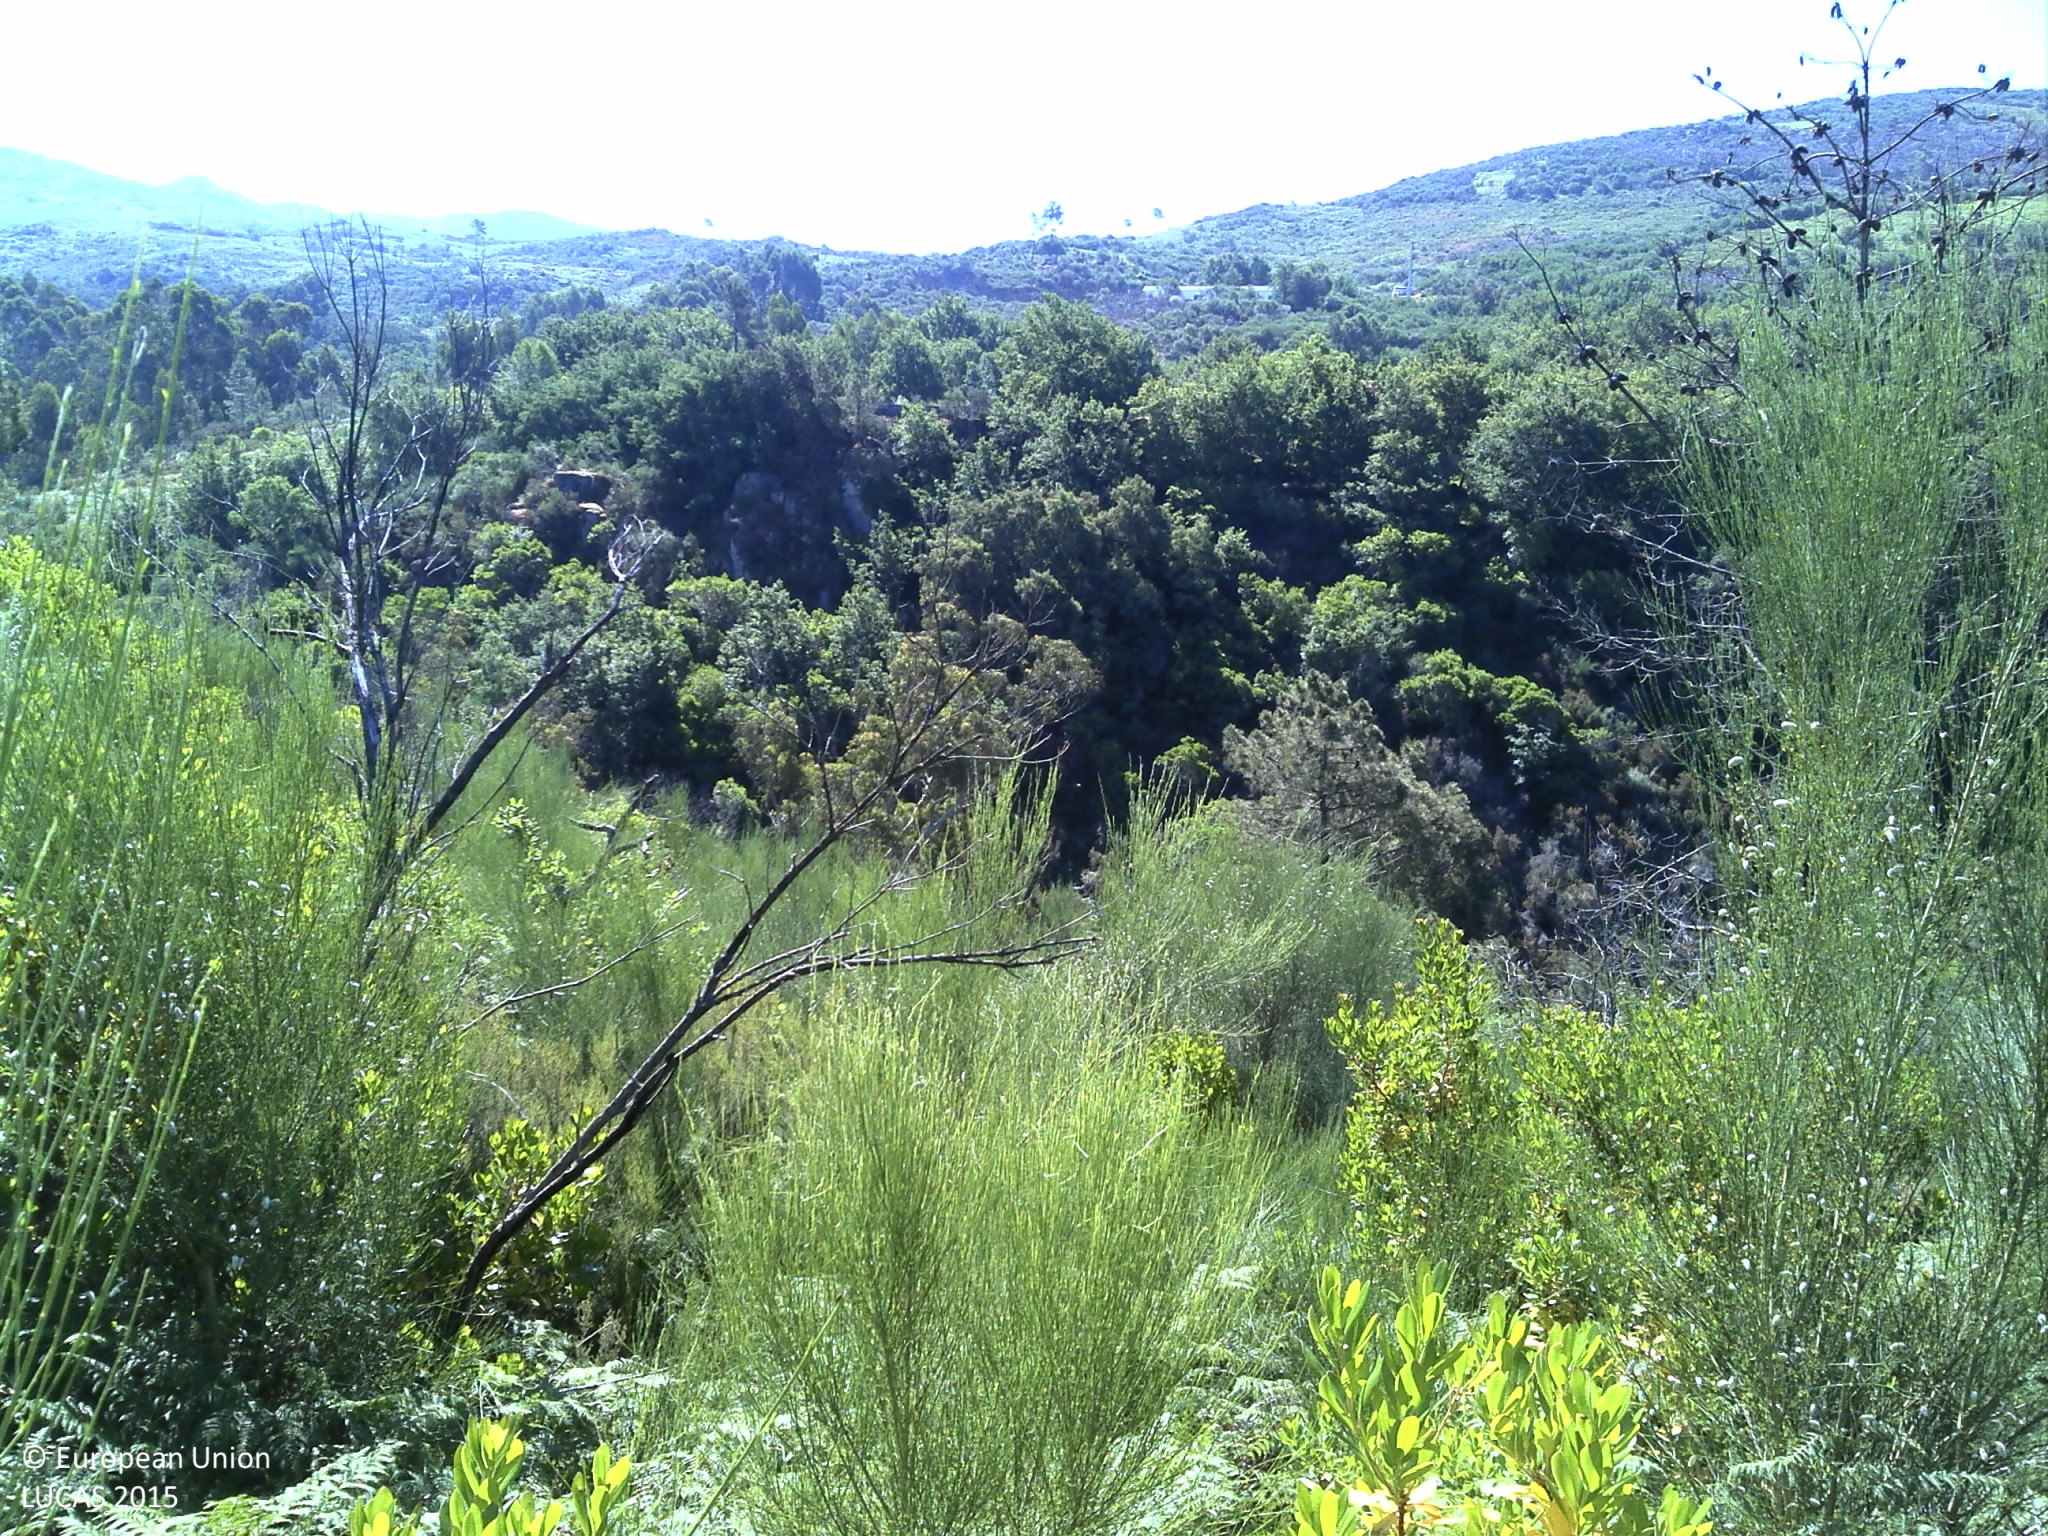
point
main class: Shrubland
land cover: Shrubland without tree cover
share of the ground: > 75 %
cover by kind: shrubs 75 %, herbaceous plants 10 %, consolidated bare surface 10 %, unconsolidated bare surface 5 %
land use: Semi-natural and natural areas not in use
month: June
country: PT
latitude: 41.8419
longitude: -8.2790
